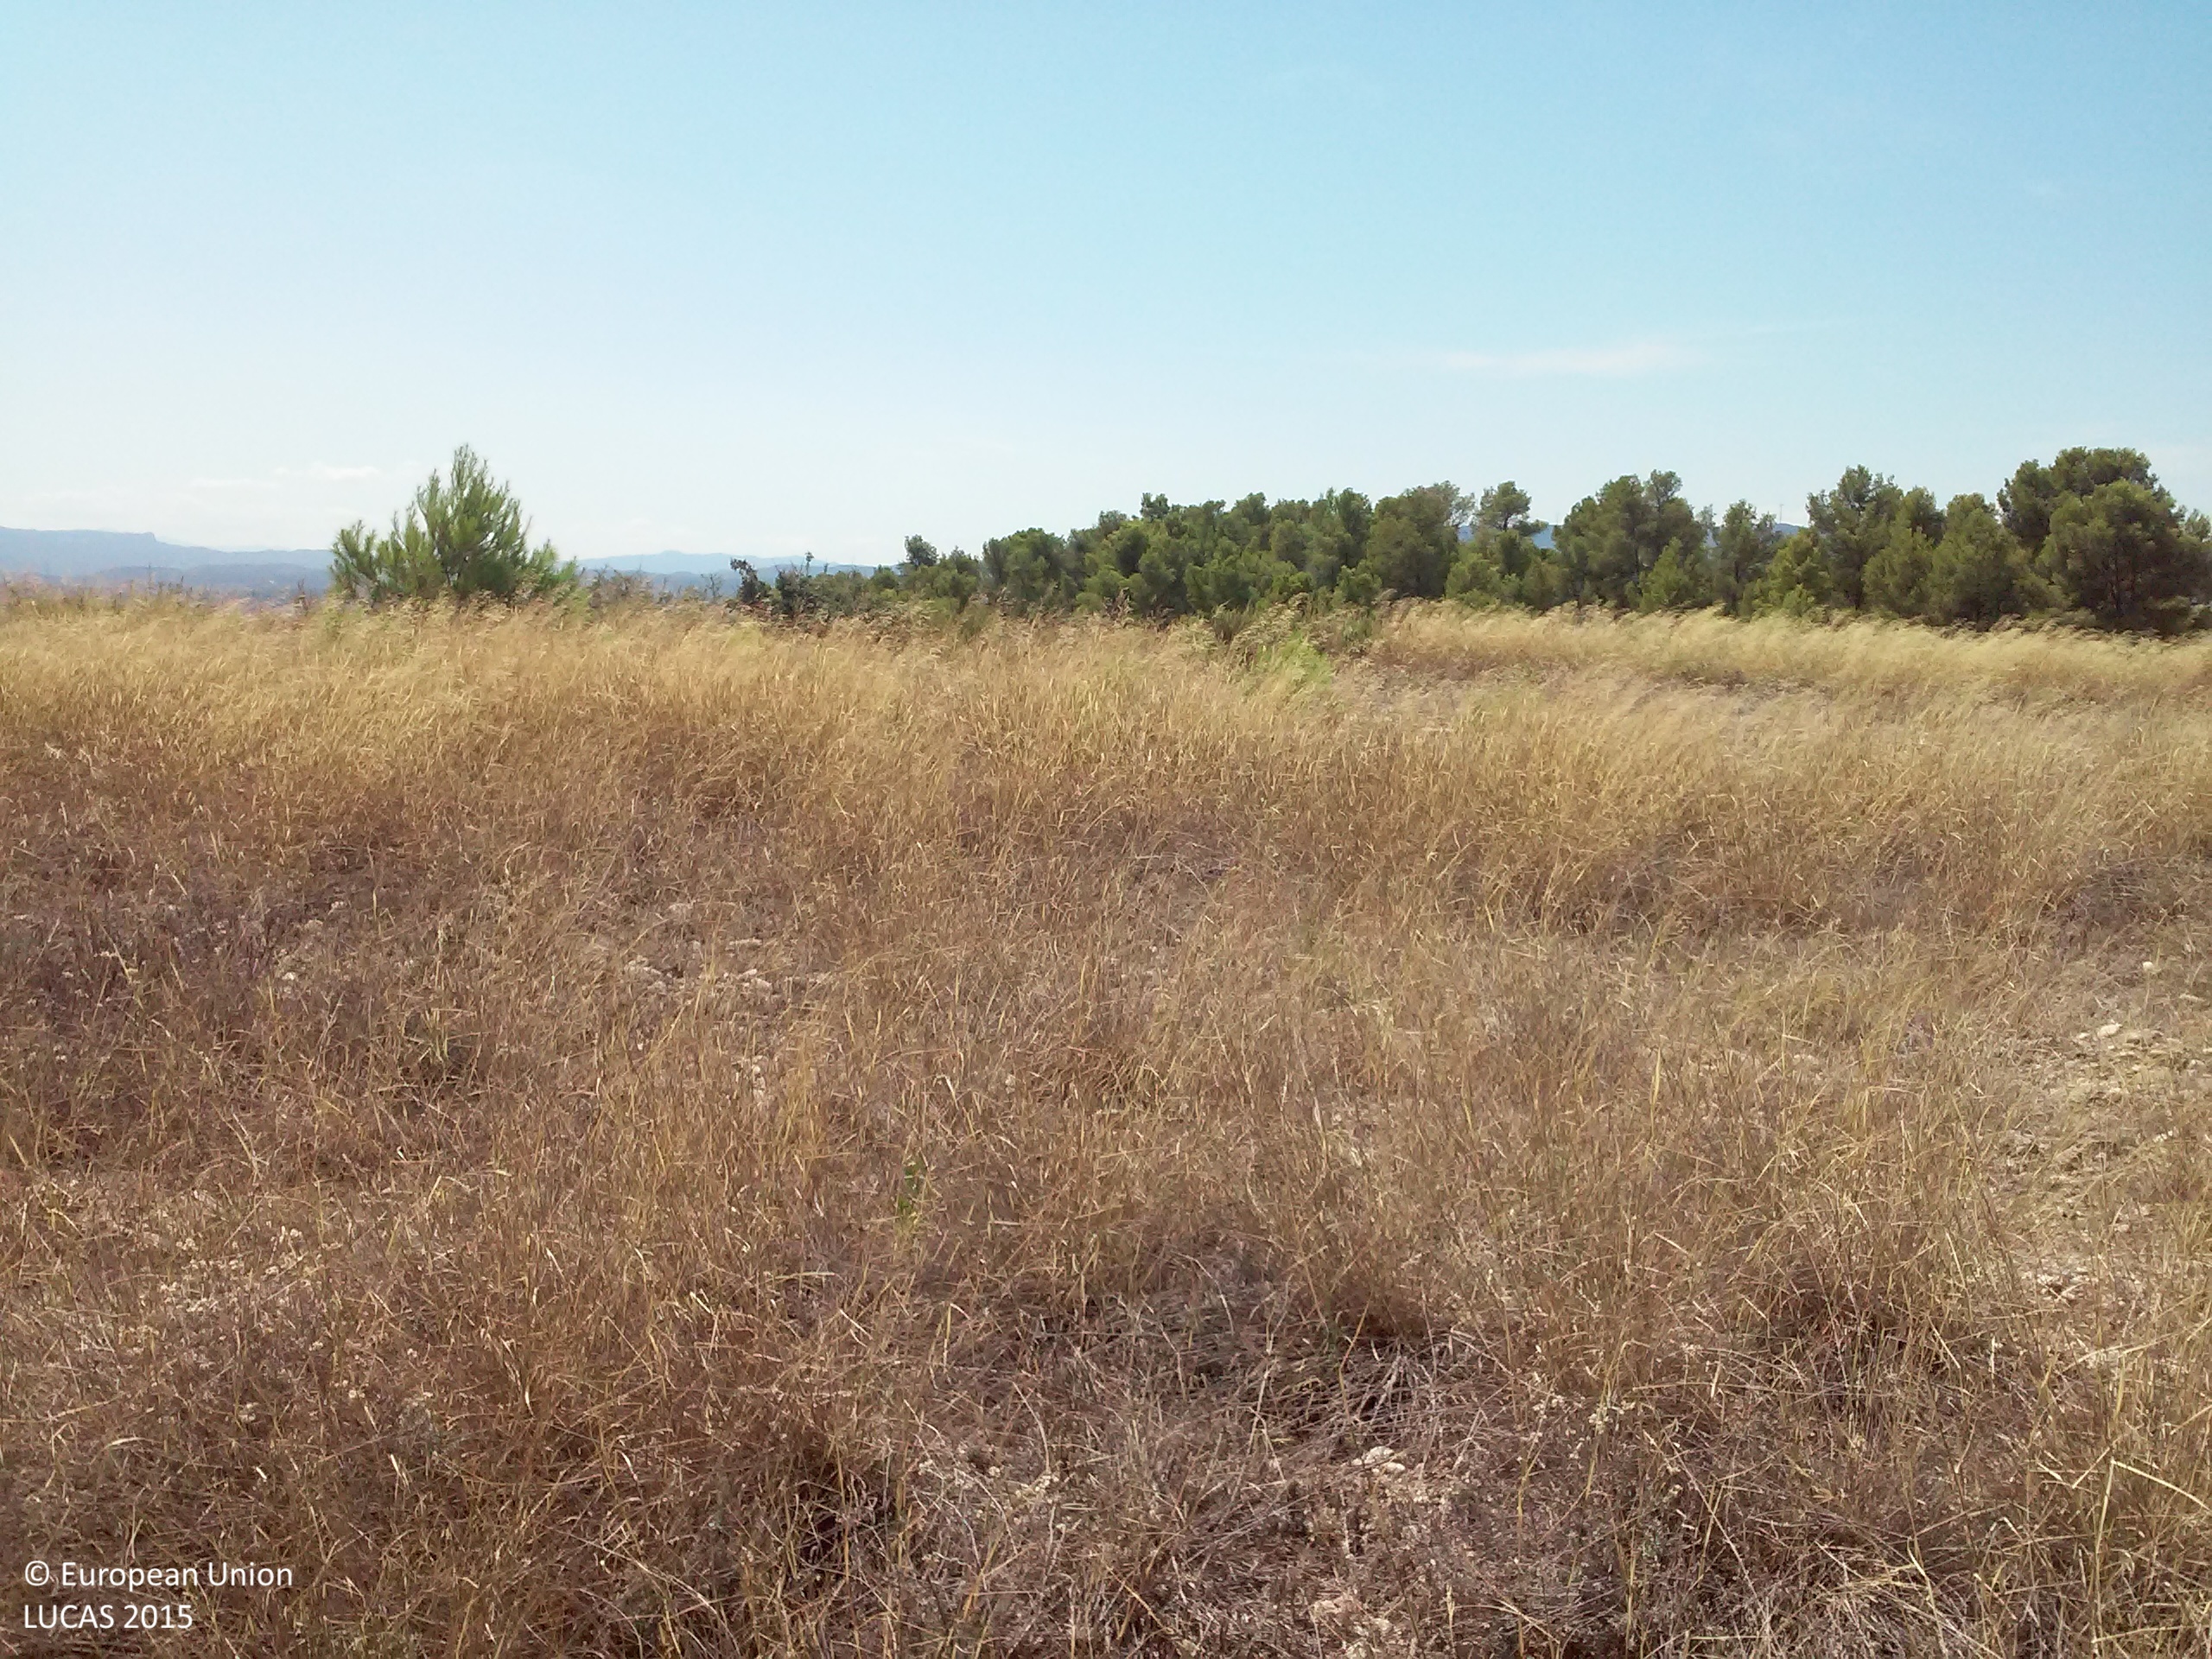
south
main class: Grassland
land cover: Grassland without tree/shrub cover
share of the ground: > 75 %
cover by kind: herbaceous plants 95 %, shrubs 5 %
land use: Abandoned areas
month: August
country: ES
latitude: 41.2479
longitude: 0.5511
